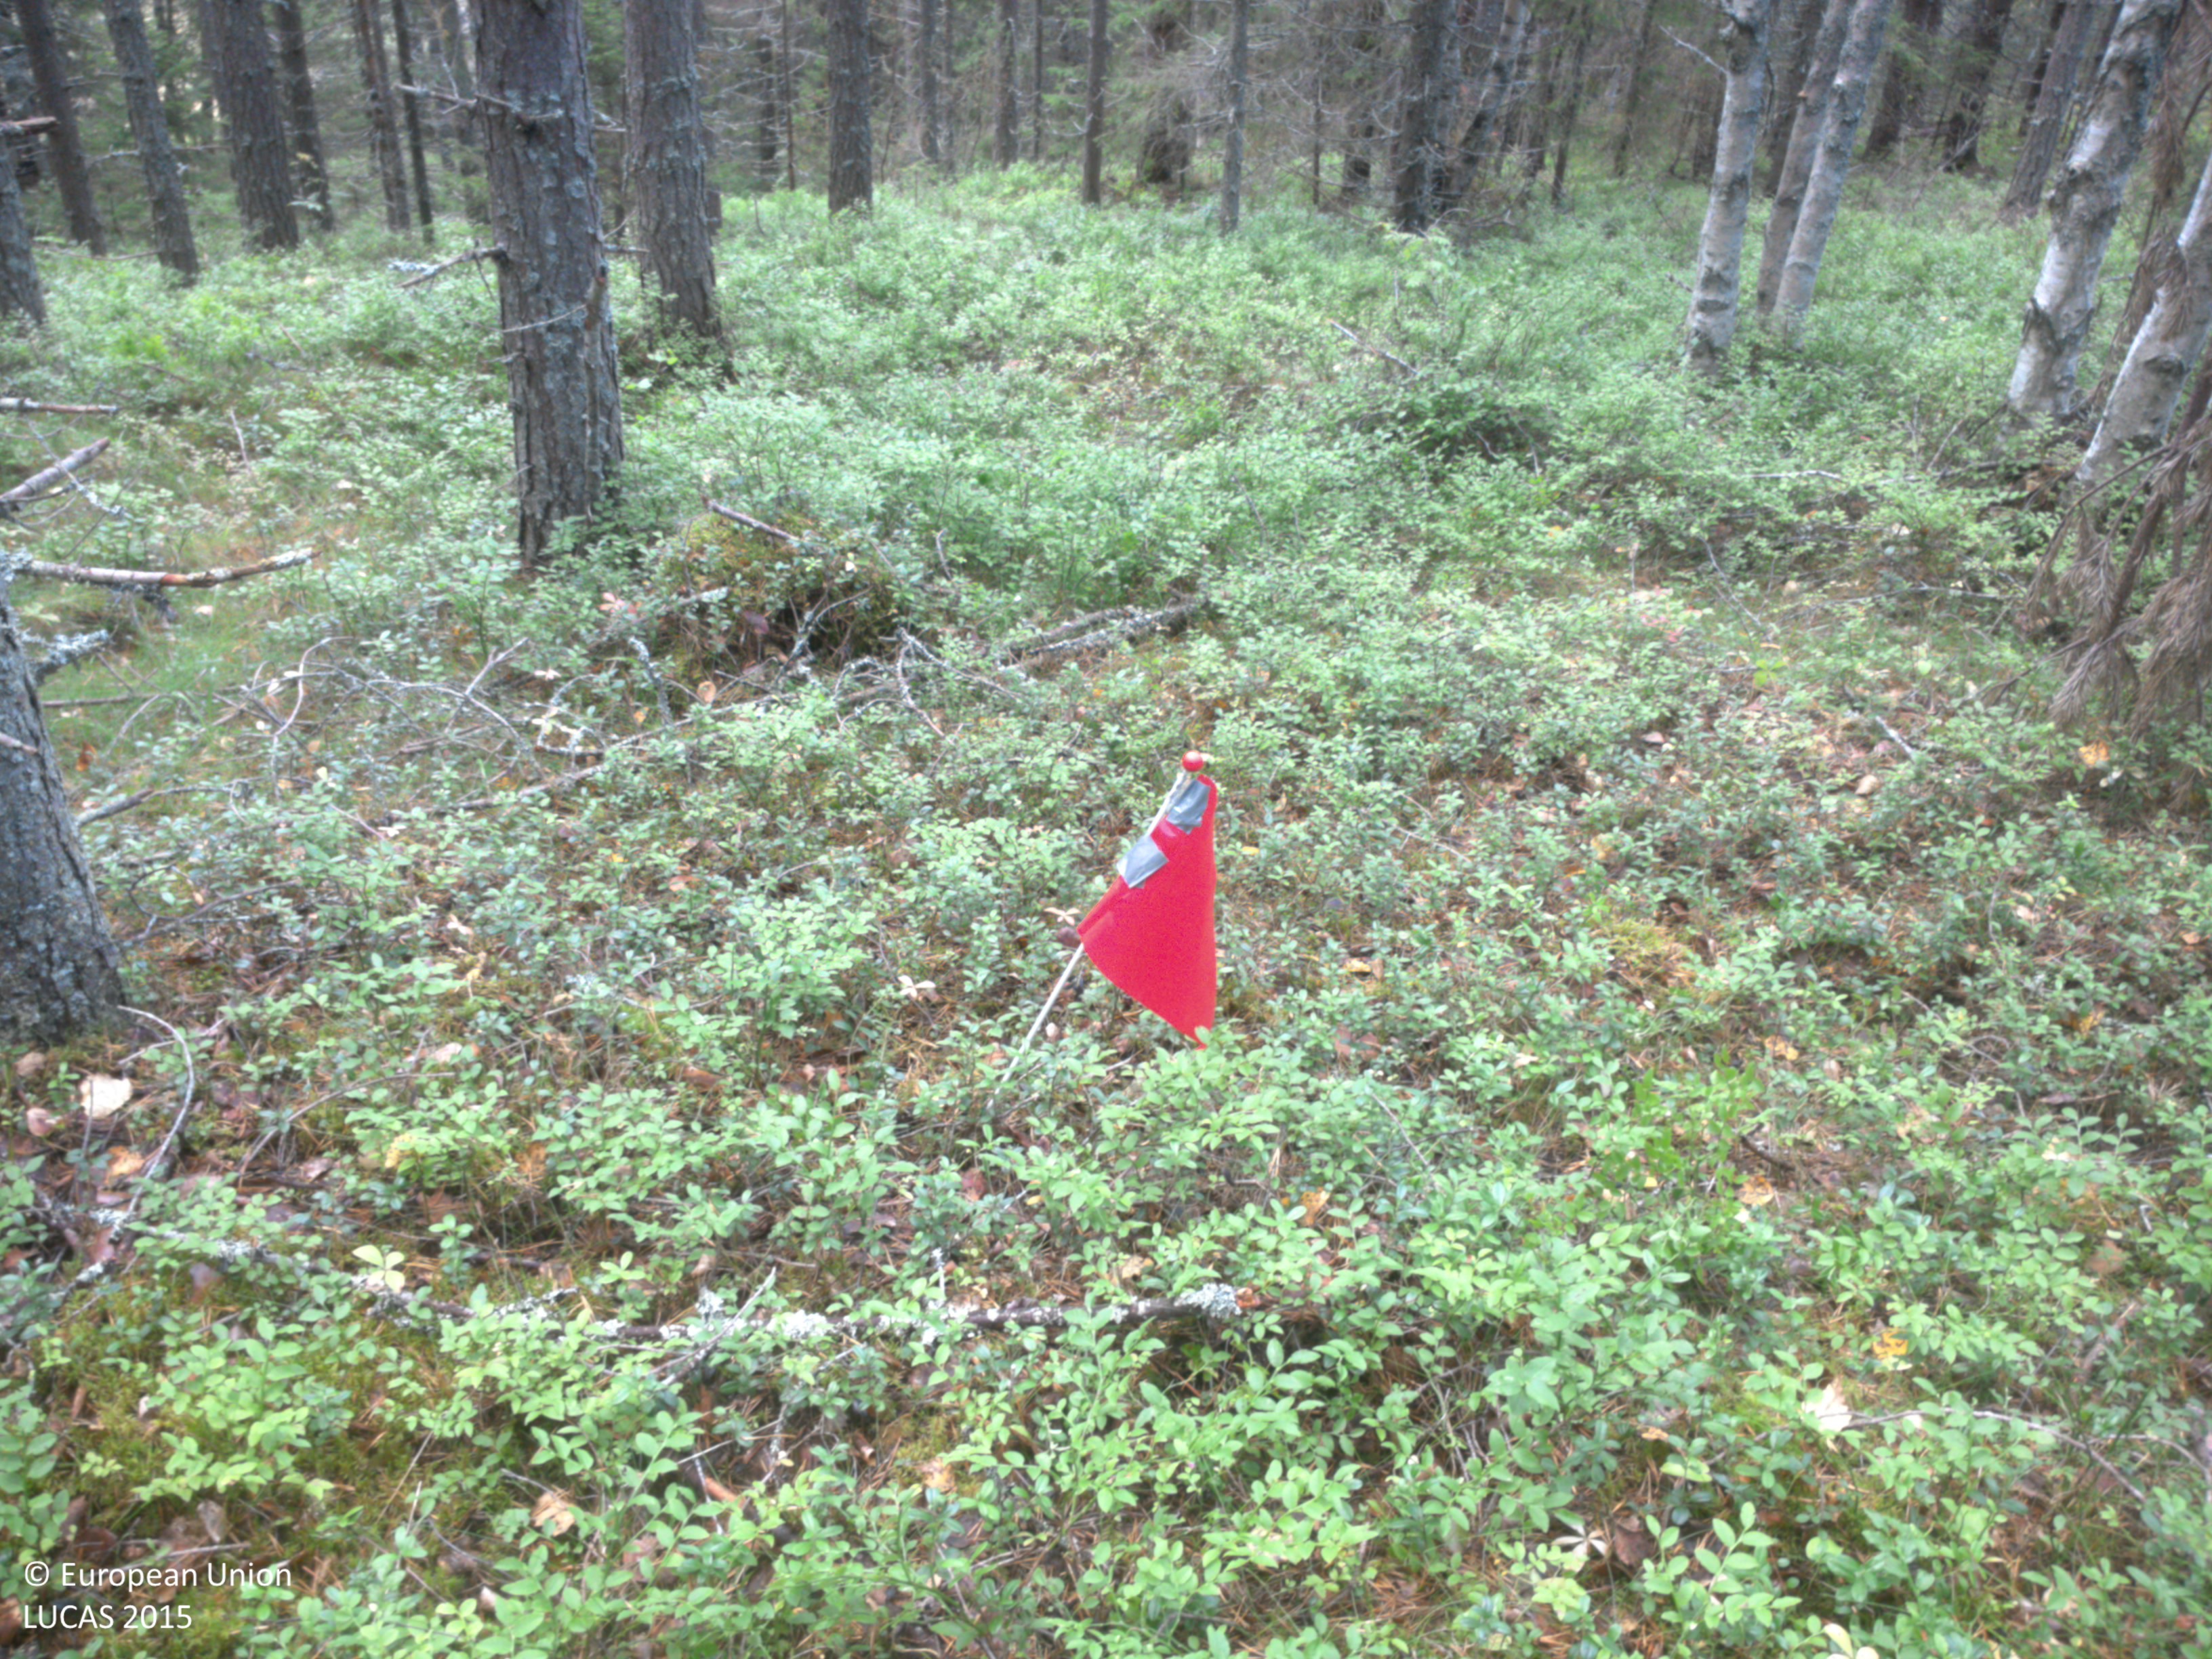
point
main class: Woodland
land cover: Pine dominated mixed woodland
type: boreal forest
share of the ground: 50 - 75 %
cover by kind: shrubs 45 %, coniferous forest trees 40 %, broadleaved forest trees 15 %
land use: Forestry
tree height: > 5 m
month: August
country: SE
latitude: 63.8473
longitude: 19.9642
